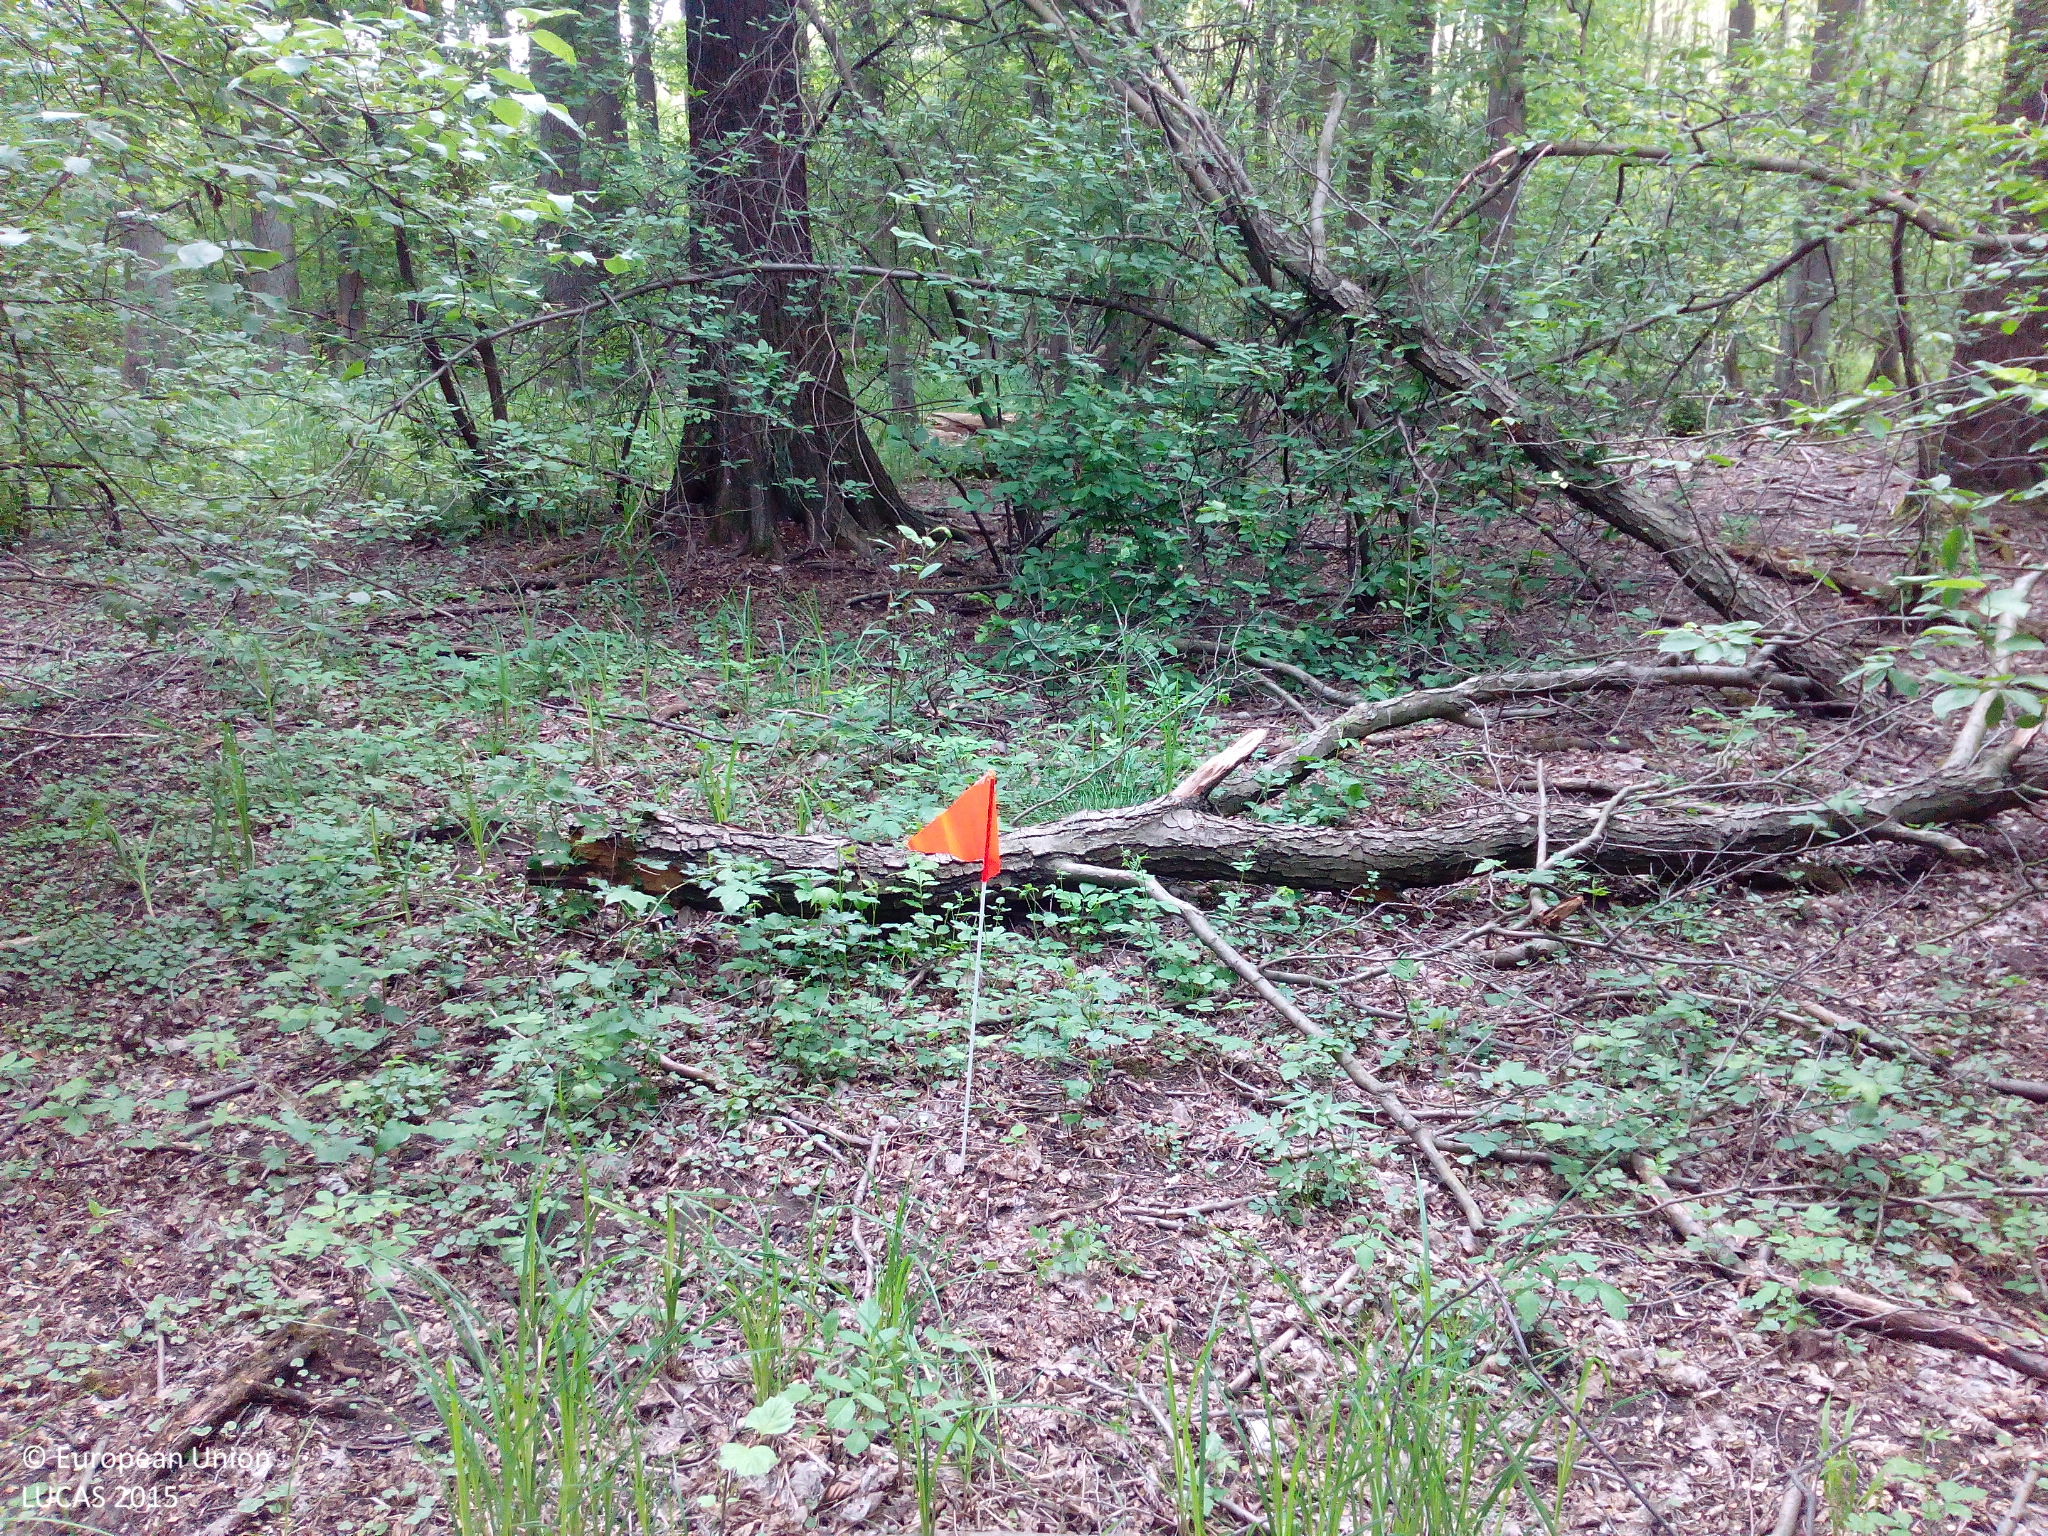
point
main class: Woodland
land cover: Broadleaved woodland
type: floodplain forest
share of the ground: > 75 %
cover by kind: broadleaved forest trees 100 %
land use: Semi-natural and natural areas not in use
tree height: > 5 m
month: May
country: DE
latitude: 51.8753
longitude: 14.0827
